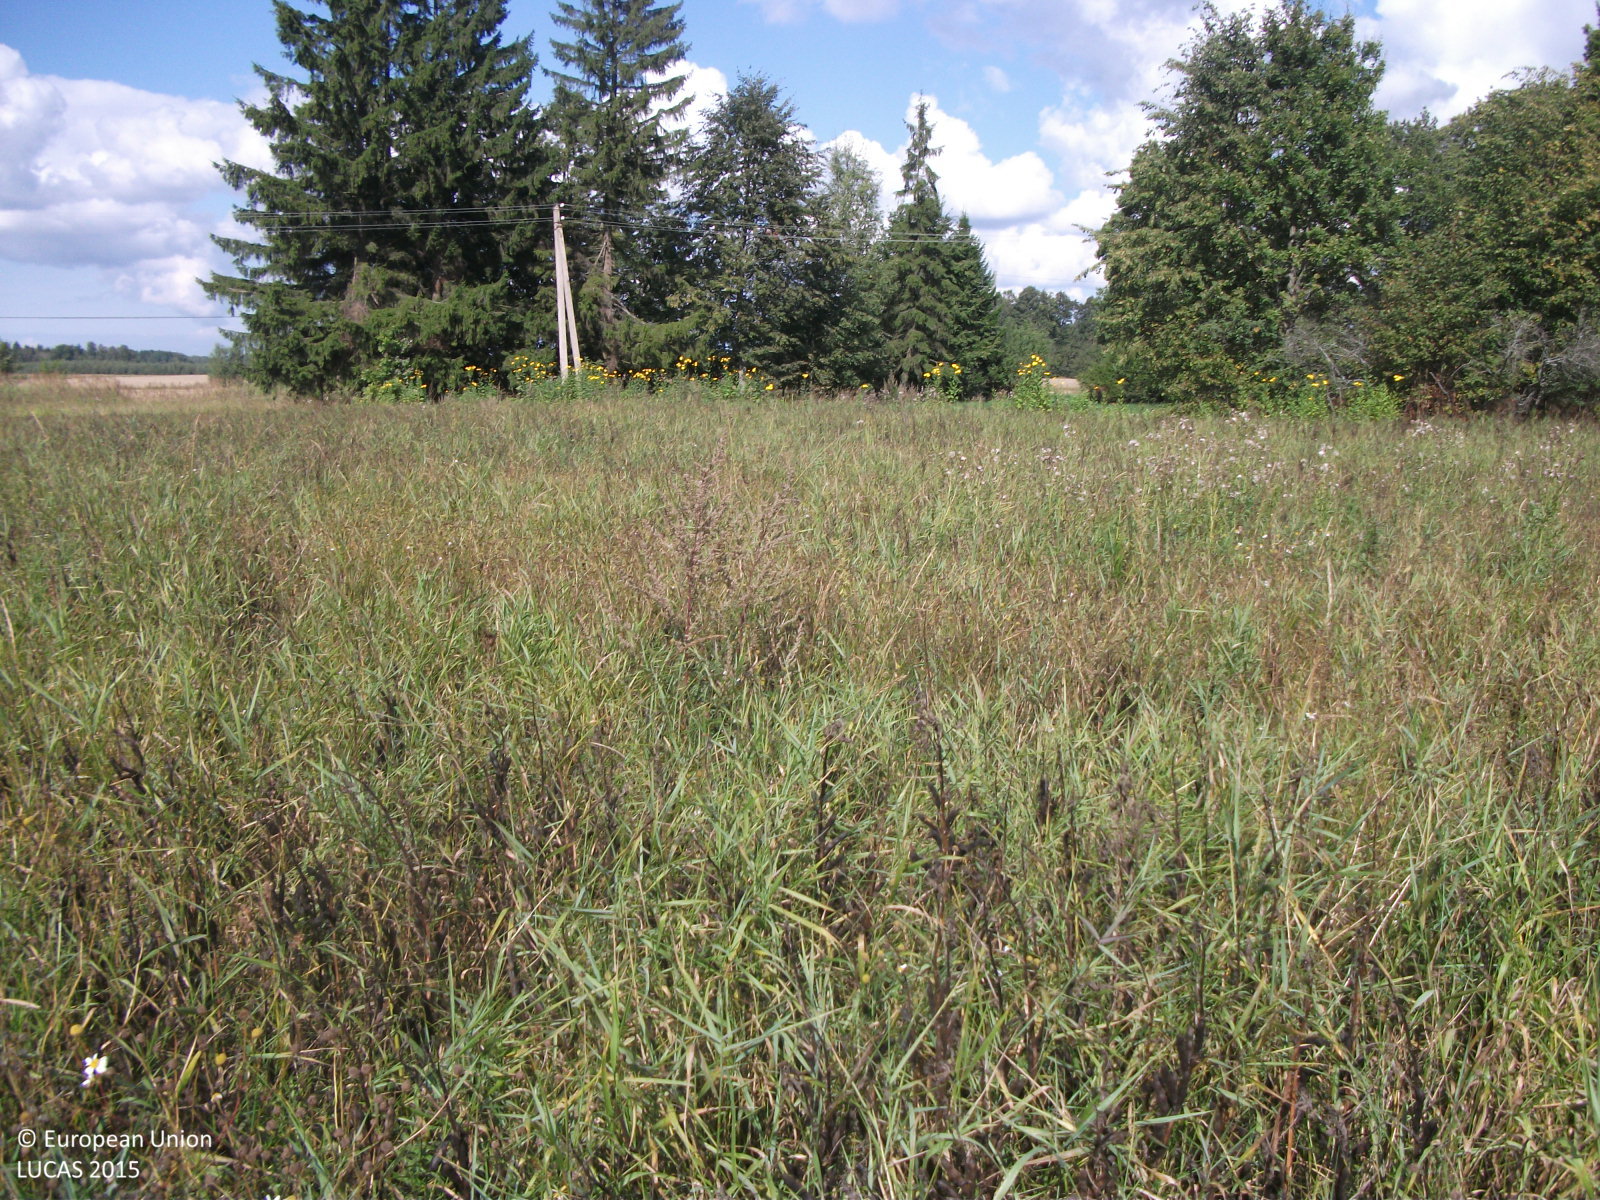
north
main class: Cropland
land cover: Dry pulses
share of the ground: > 75 %
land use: Agriculture (excluding fallow land and kitchen gardens)
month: September
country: LV
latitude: 57.4837
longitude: 24.4854
